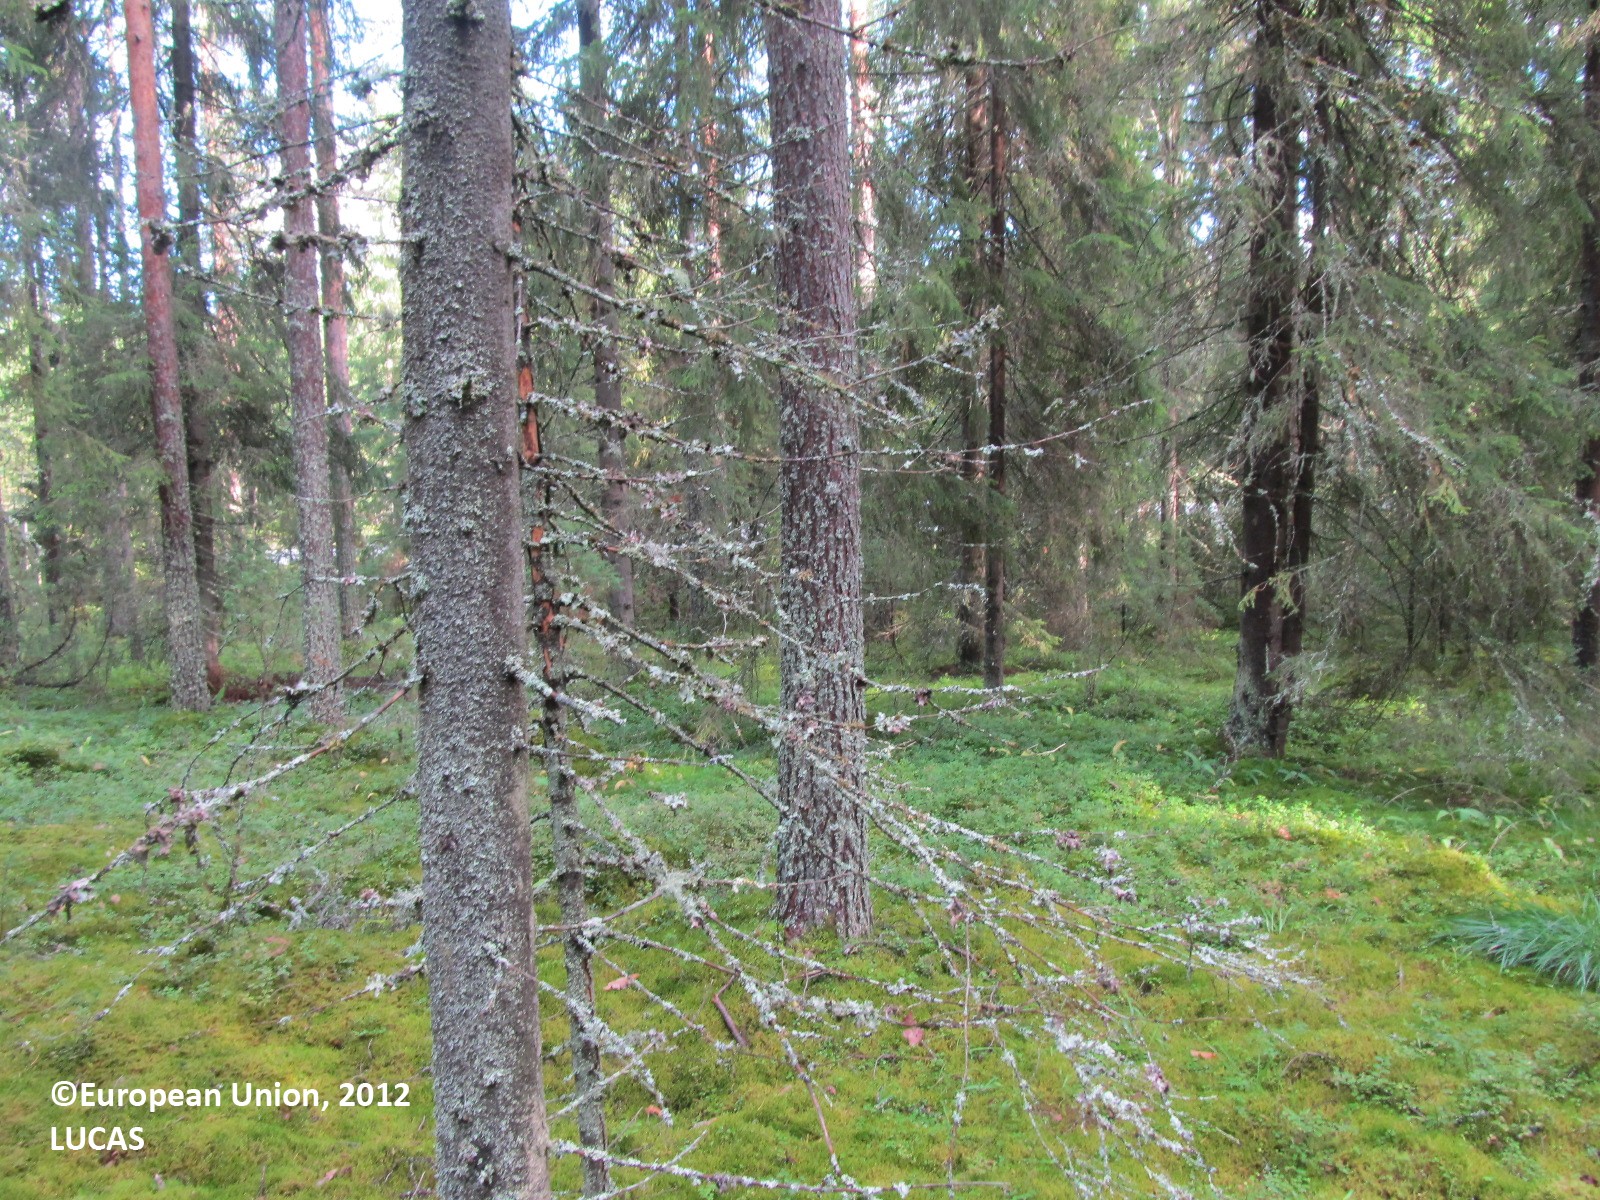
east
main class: Woodland
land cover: Spruce dominated coniferous woodland
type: boreal forest
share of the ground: 50 - 75 %
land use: Forestry
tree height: > 5 m
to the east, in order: Spruce dominated coniferous woodland; Ditches and canals; Paved roads, cycling and walking lanes; Ditches and canals; Spruce dominated coniferous woodland
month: September
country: FI
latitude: 62.9097
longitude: 28.4404
